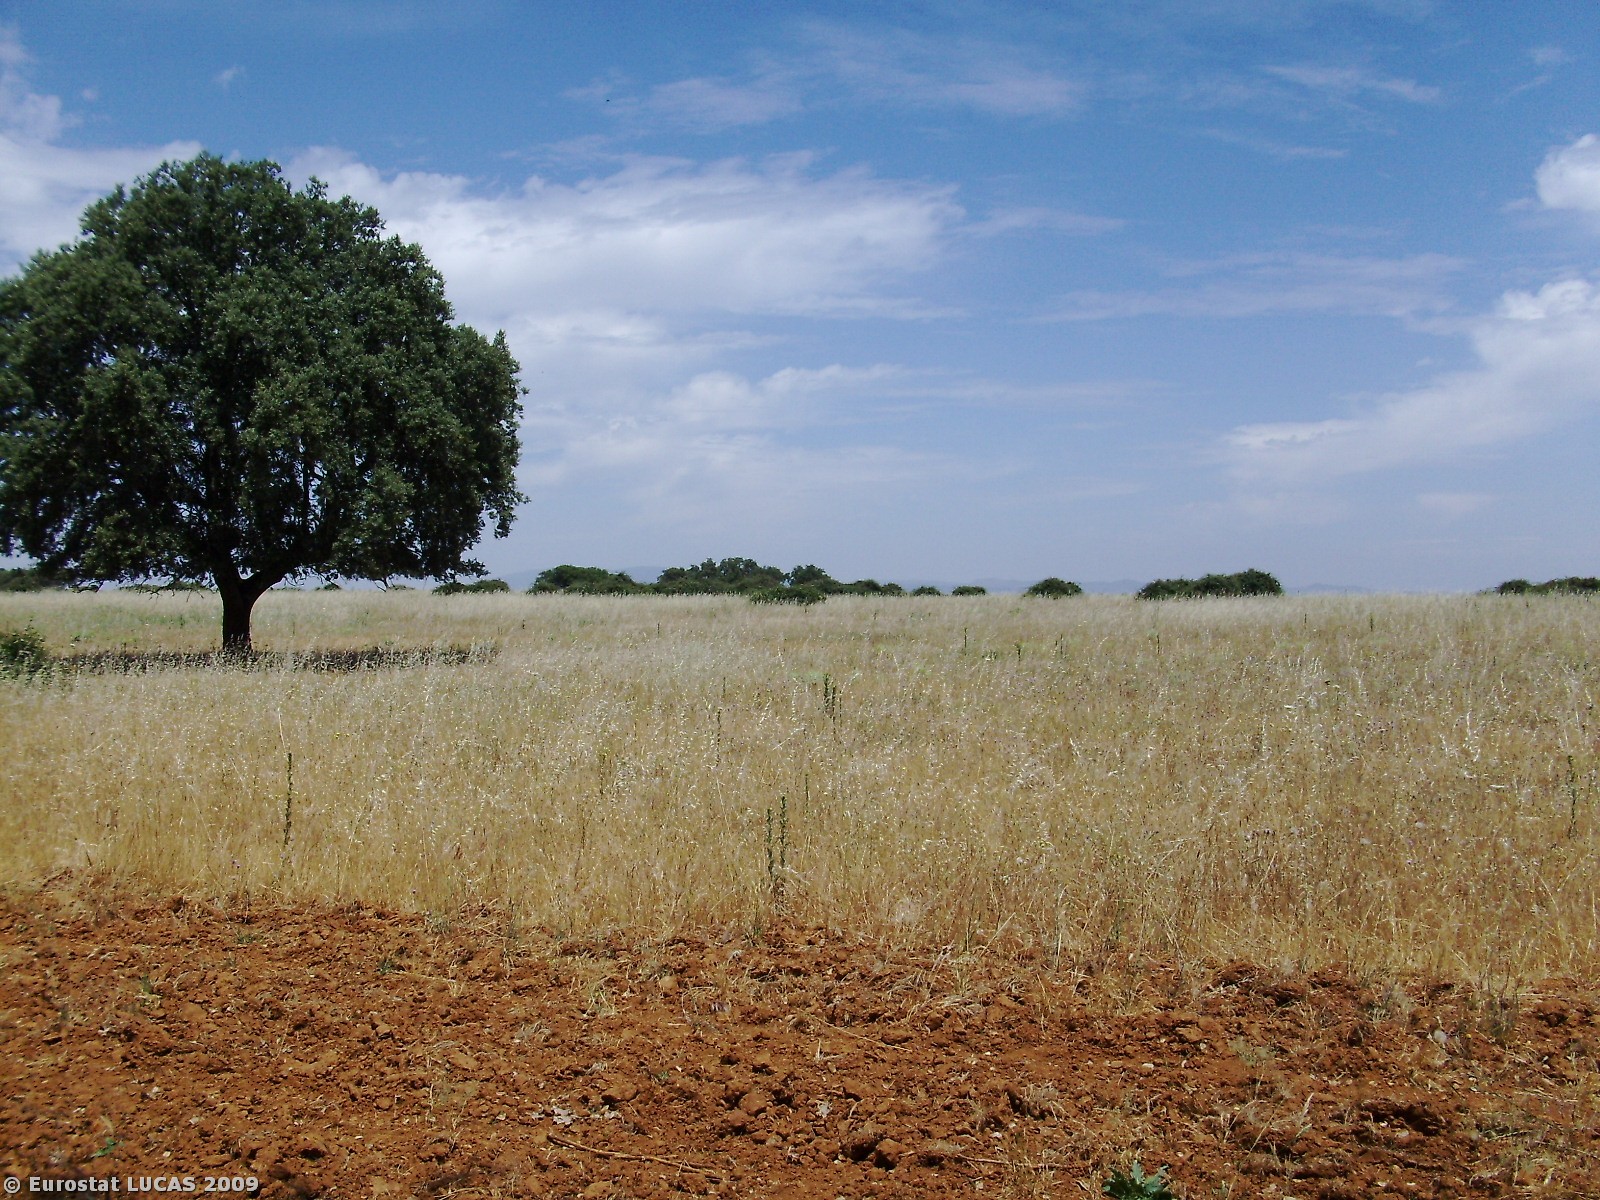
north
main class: Grassland
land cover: Grassland with sparse tree/shrub cover
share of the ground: 50 - 75 %
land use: Fallow land
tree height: > 5 m
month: June
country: PT
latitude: 39.1453
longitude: -7.3817
